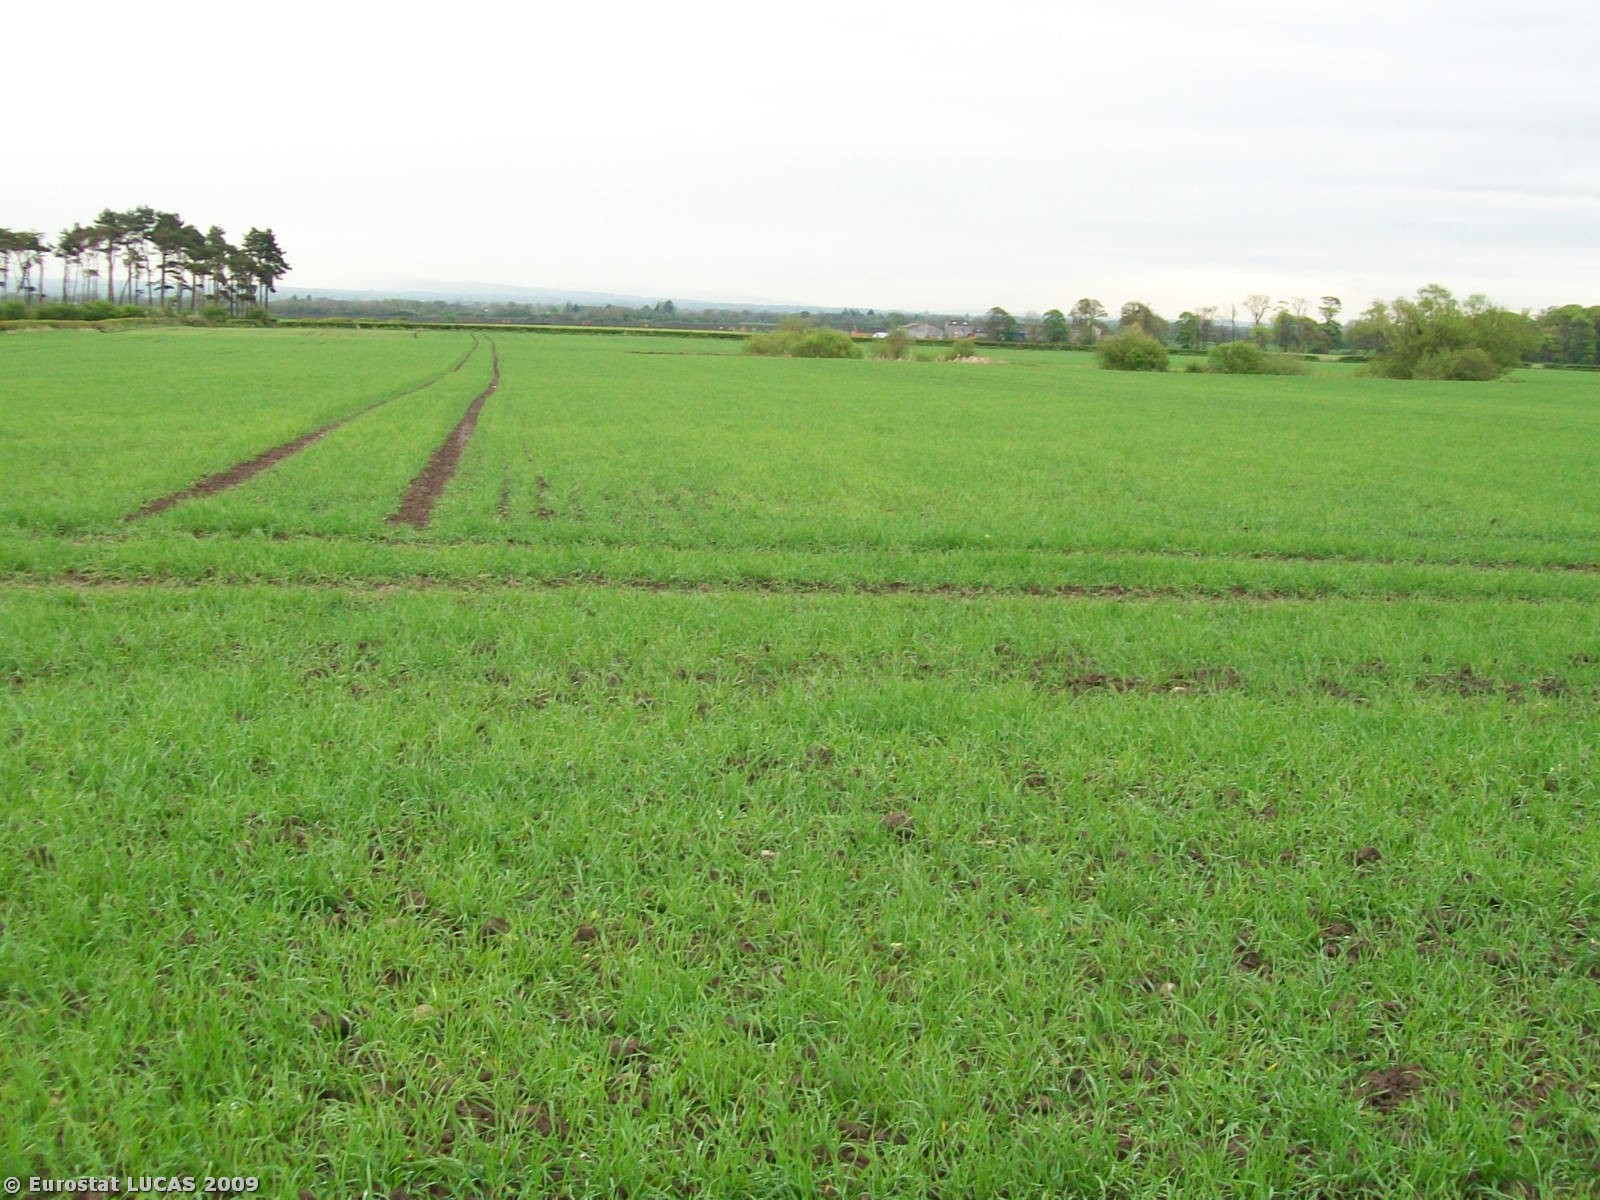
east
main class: Cropland
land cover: Common wheat
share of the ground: 50 - 75 %
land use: Agriculture (excluding fallow land and kitchen gardens)
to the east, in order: Common wheat; Managed hedges; Grassland without tree/shrub cover; Artificial constructions in urban areas; Grassland without tree/shrub cover; Managed hedges; Grassland without tree/shrub cover; Single bushes/trees
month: May
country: GB
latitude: 53.8012
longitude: -2.9019
